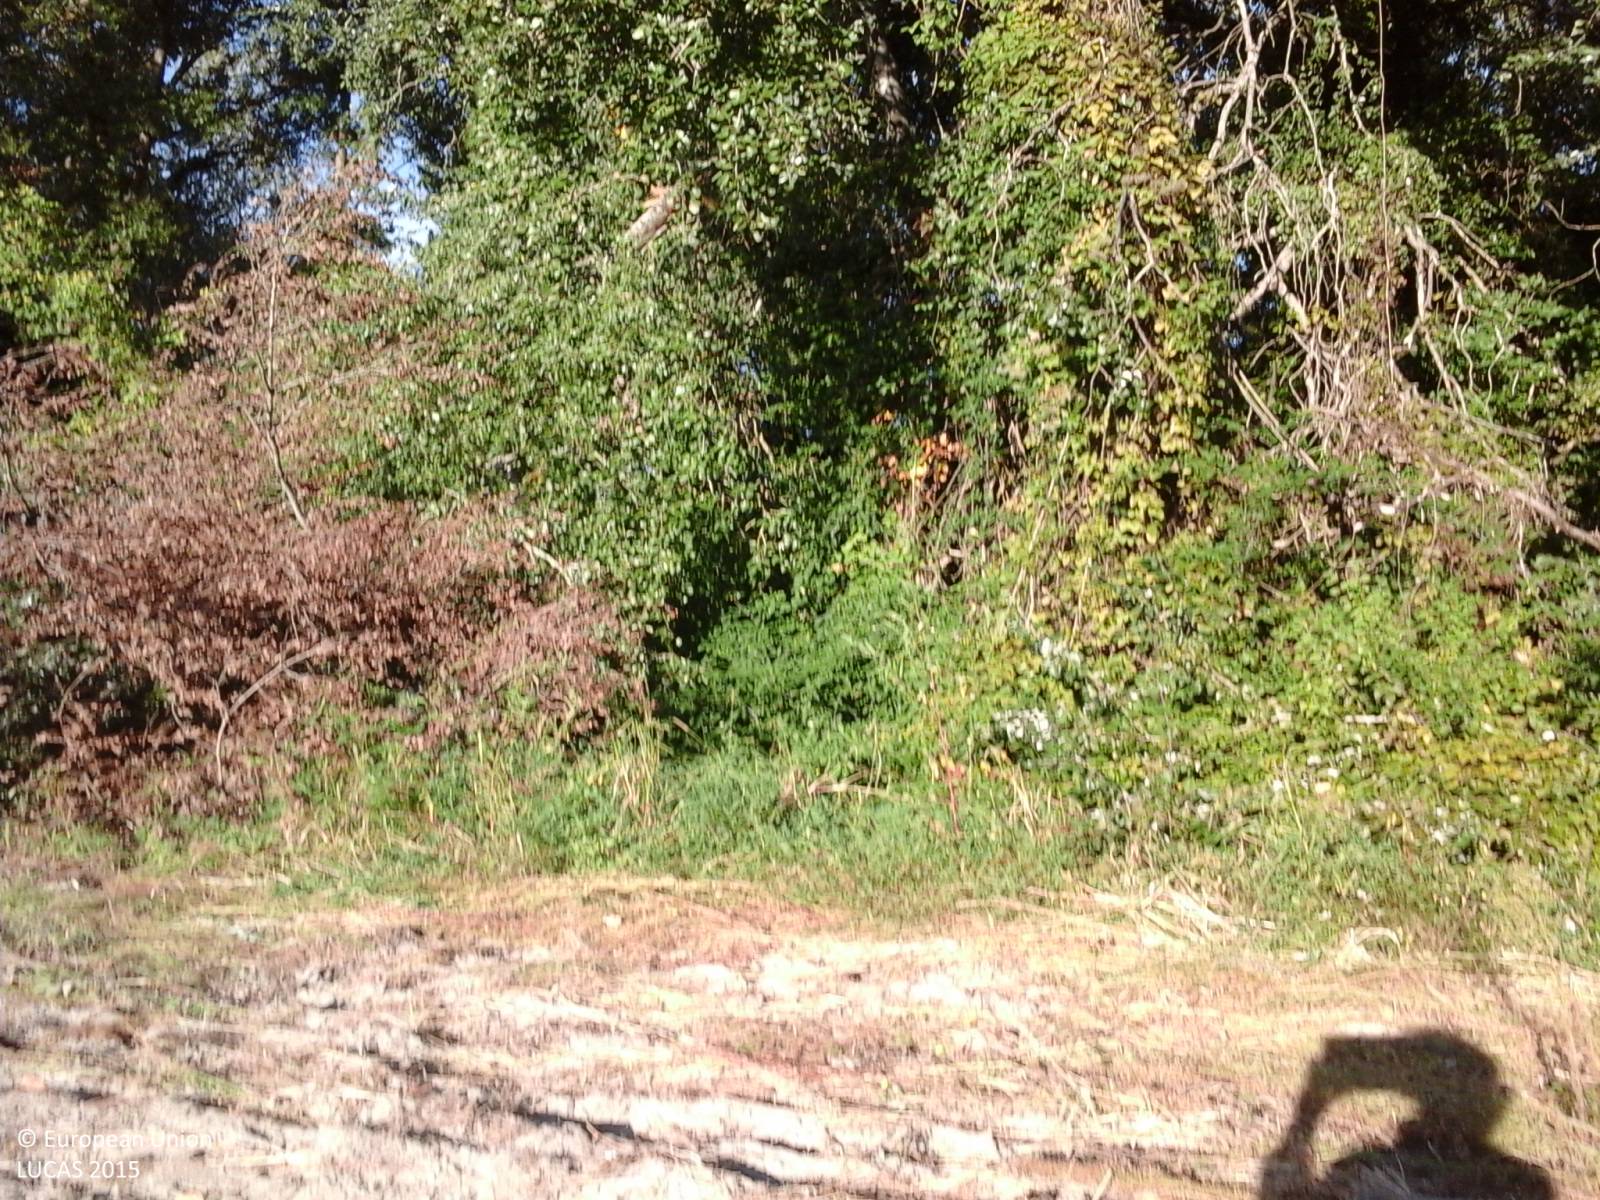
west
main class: Cropland
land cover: Durum wheat
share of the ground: < 10 %
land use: Agriculture (excluding fallow land and kitchen gardens)
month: September
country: IT
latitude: 42.6116
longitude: 12.2236
